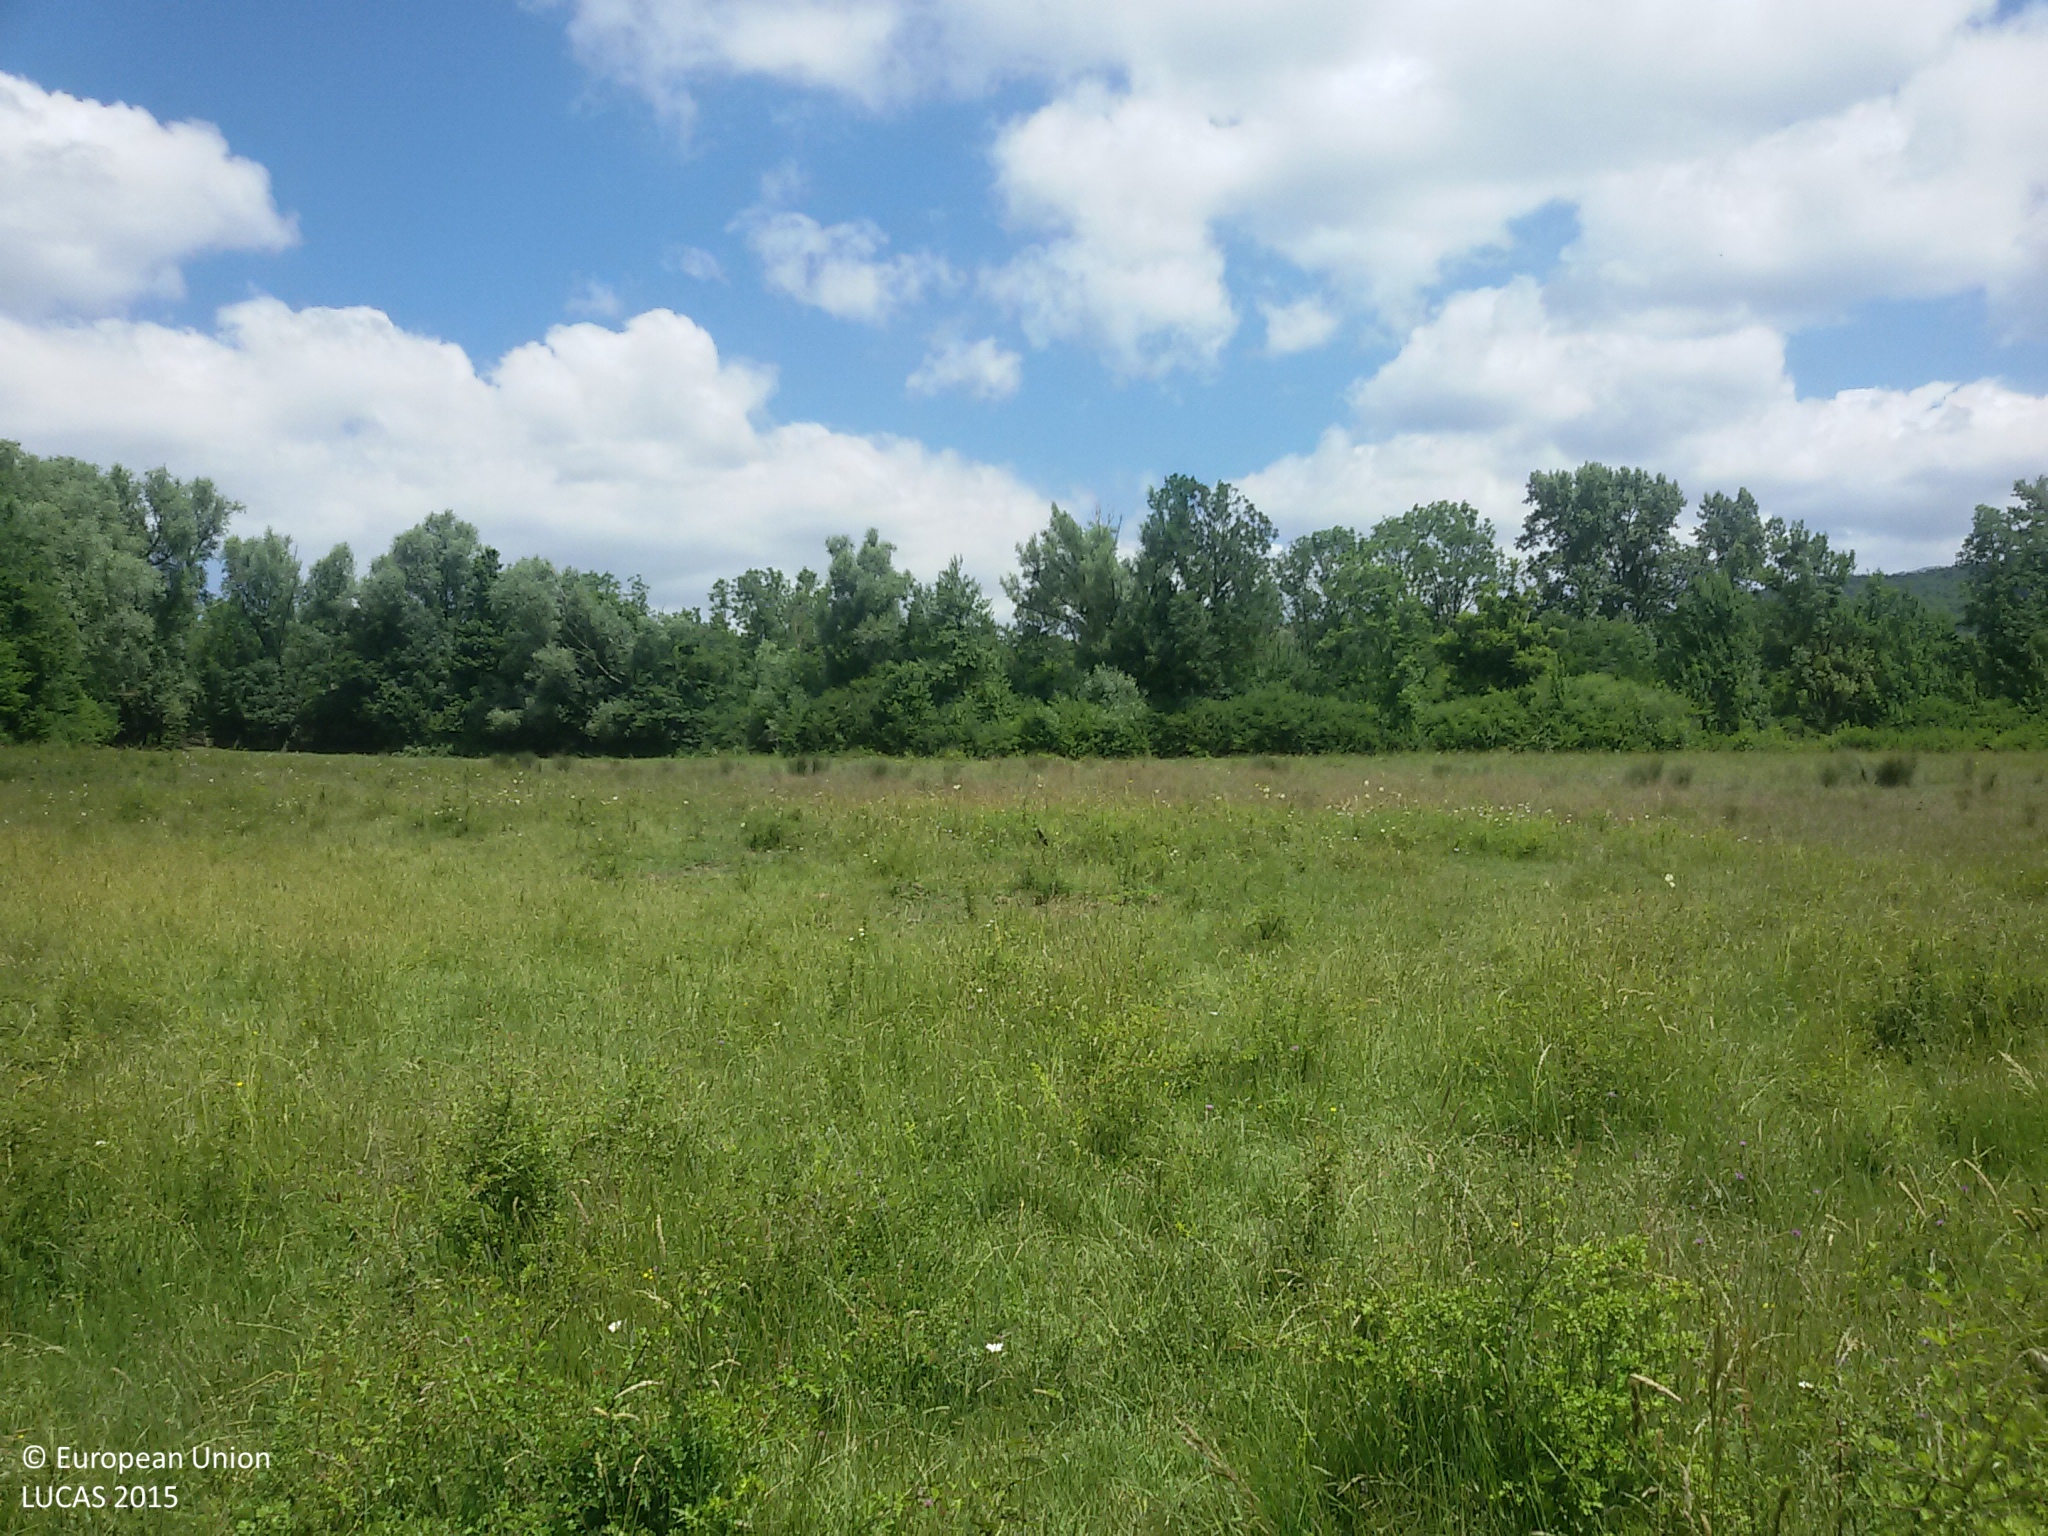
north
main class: Grassland
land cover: Grassland without tree/shrub cover
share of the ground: > 75 %
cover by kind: herbaceous plants 90 %, shrubs 5 %, unconsolidated bare surface 5 %
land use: Agriculture (excluding fallow land and kitchen gardens)
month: June
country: HR
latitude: 44.5155
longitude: 15.7680
